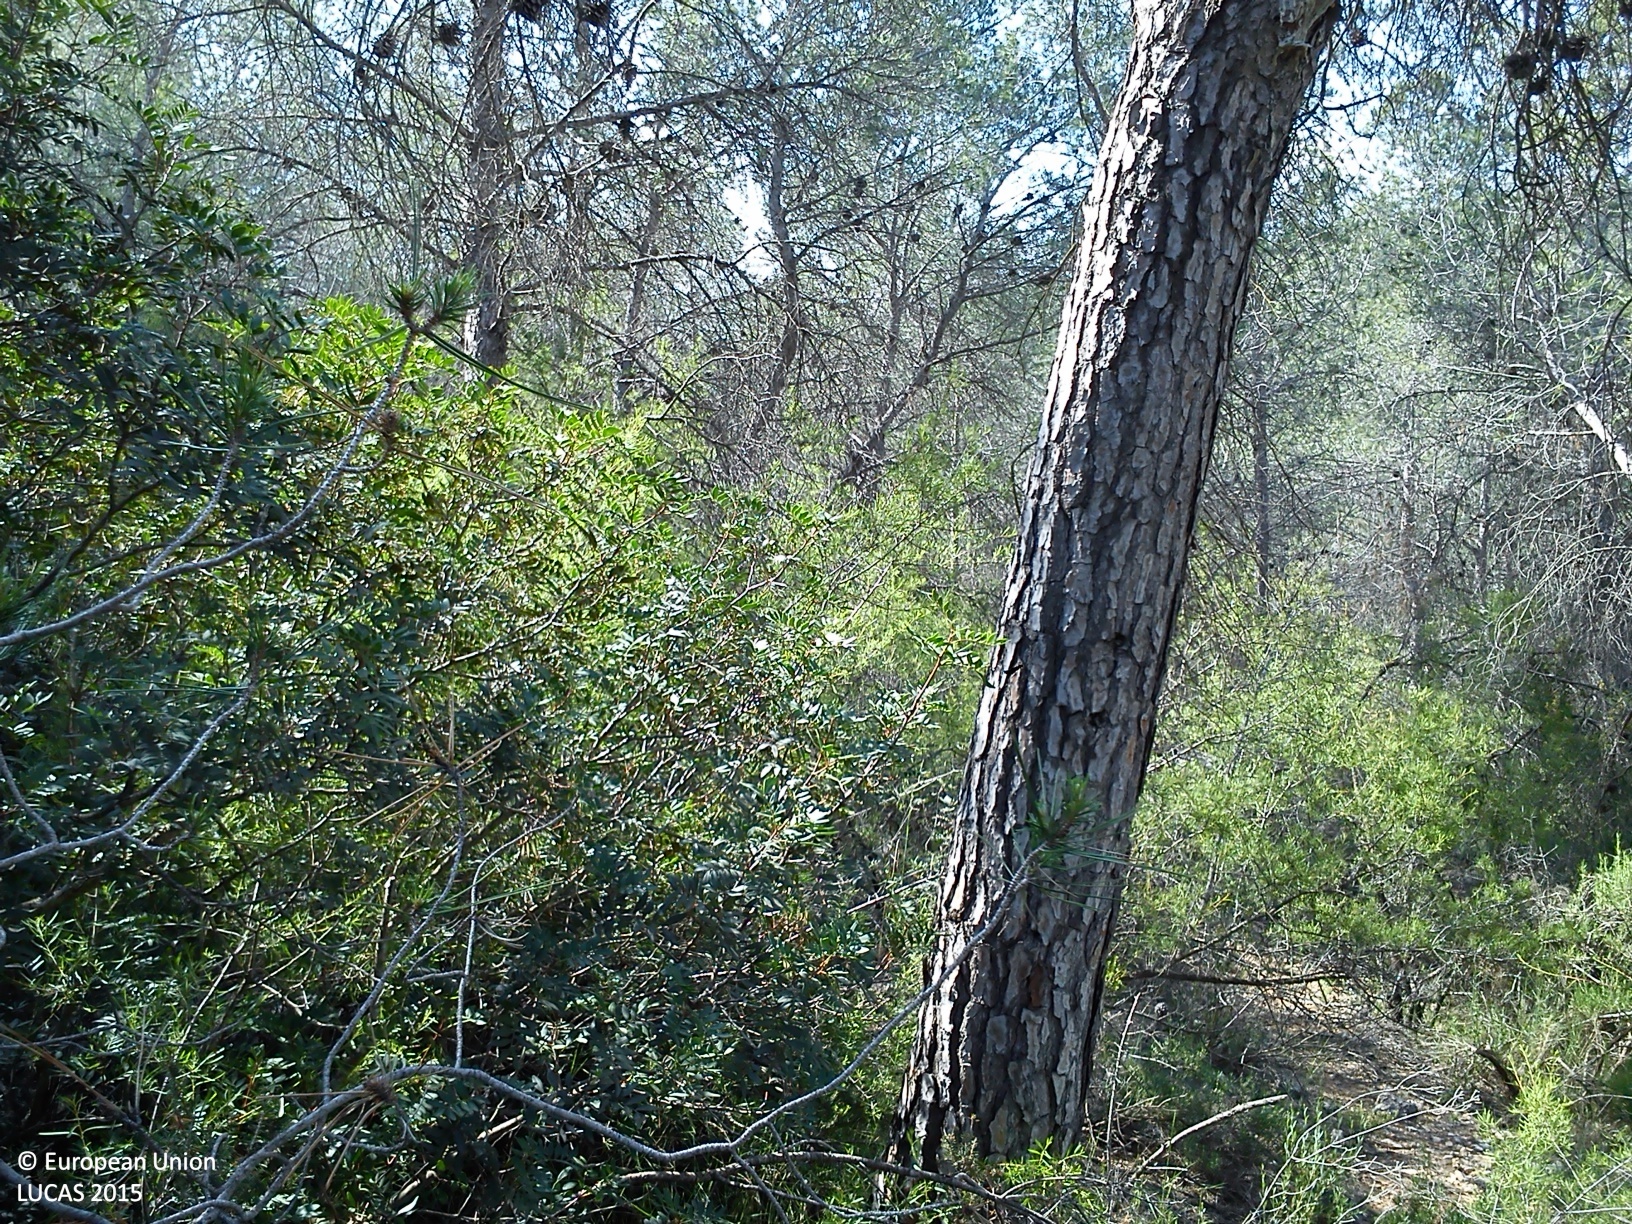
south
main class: Woodland
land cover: Pine dominated coniferous woodland
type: coniferous forest of the mediterranean region
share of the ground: > 75 %
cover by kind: coniferous forest trees 75 %, shrubs 15 %, herbaceous plants 5 %, consolidated bare surface 5 %
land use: Forestry
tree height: > 5 m
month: April
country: ES
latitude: 39.6147
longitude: -0.6348
